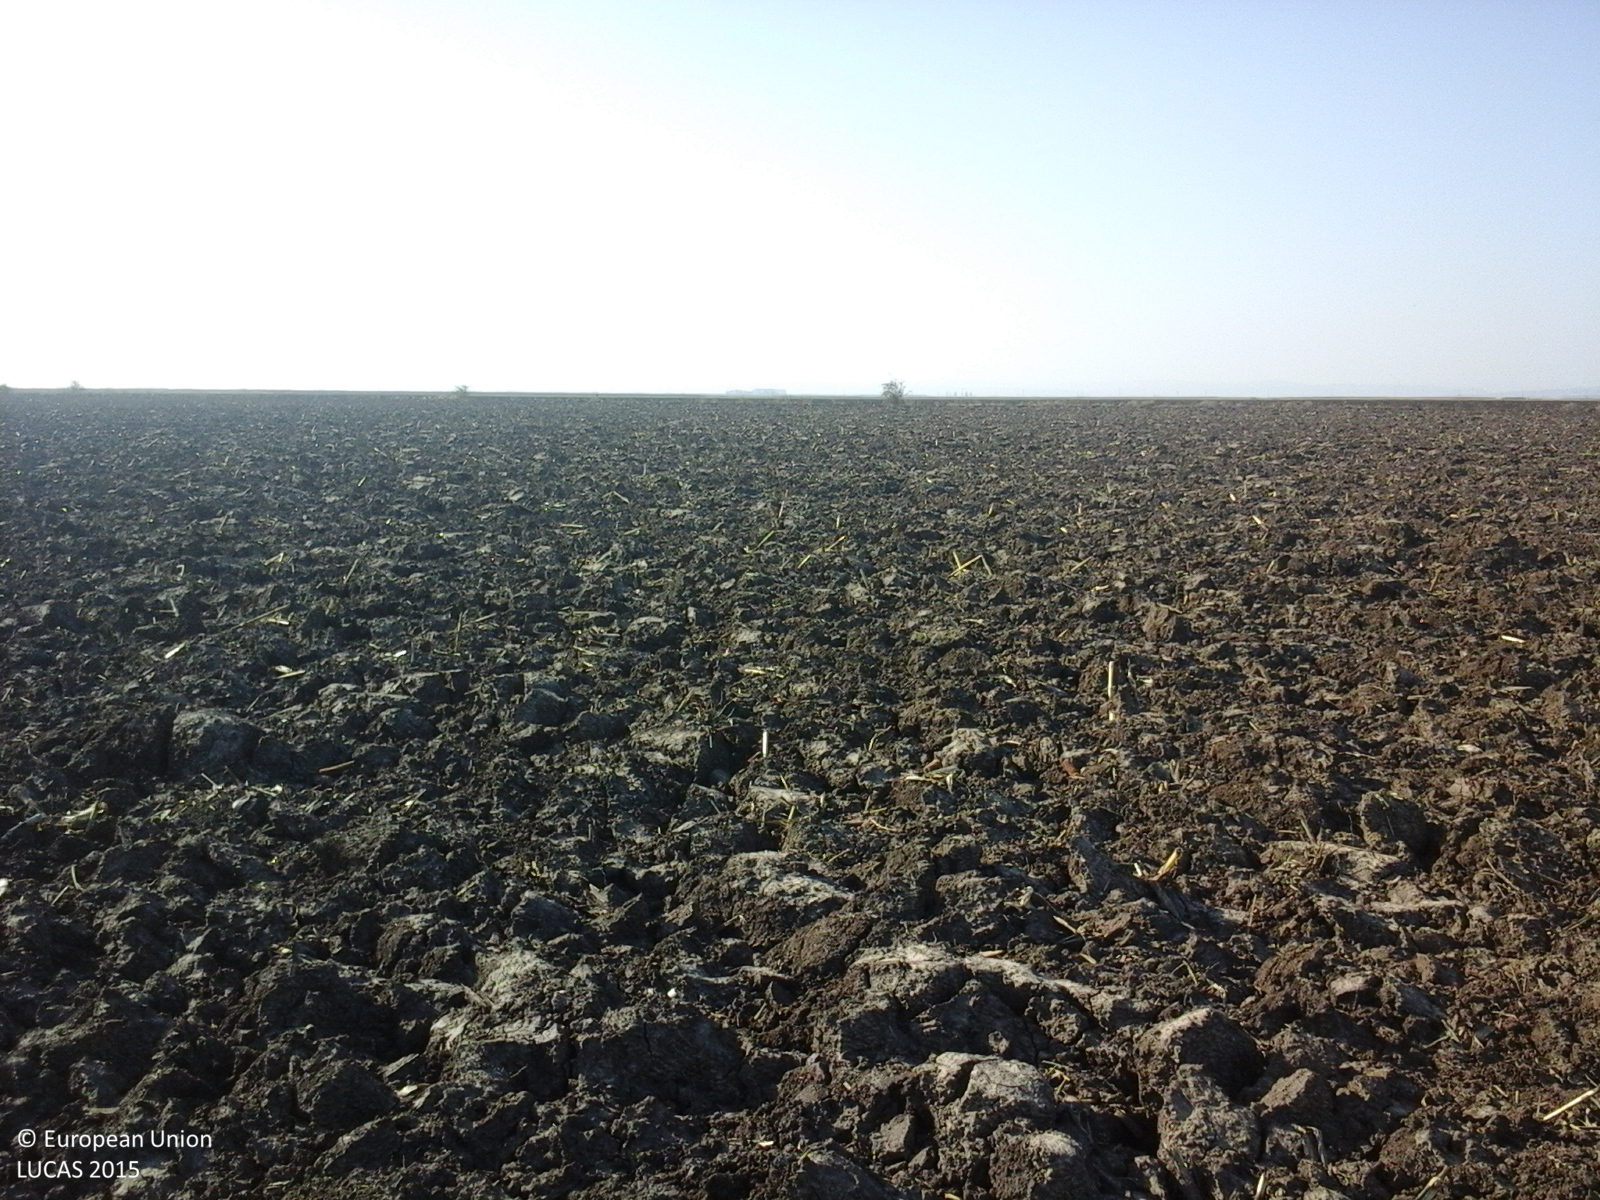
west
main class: Cropland
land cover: Maize
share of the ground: < 10 %
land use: Agriculture (excluding fallow land and kitchen gardens)
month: October
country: RO
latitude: 45.1627
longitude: 26.9921
